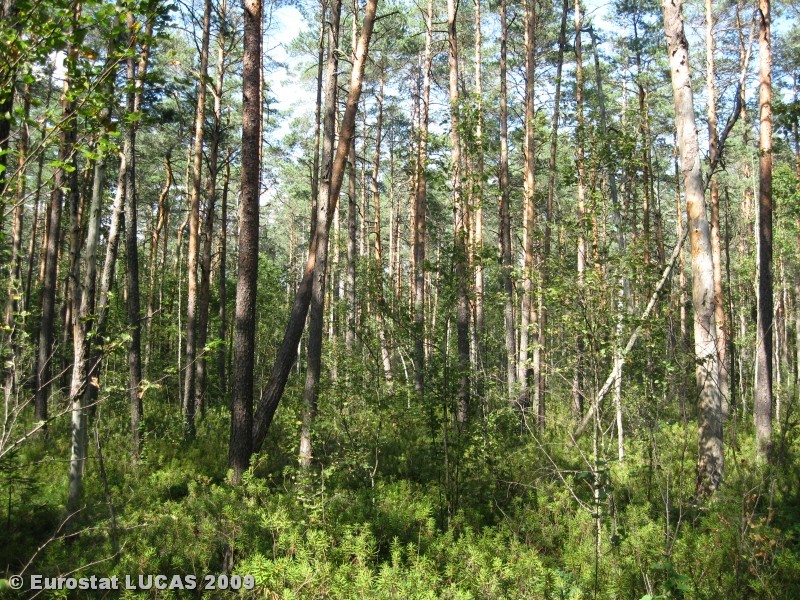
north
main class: Woodland
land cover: Mixed woodland
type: hemiboreal forest and nemoral coniferous forest and mixed broadleaved-coniferous forest
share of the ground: > 75 %
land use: Forestry
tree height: > 5 m
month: August
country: LT
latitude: 54.8050
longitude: 23.5709
